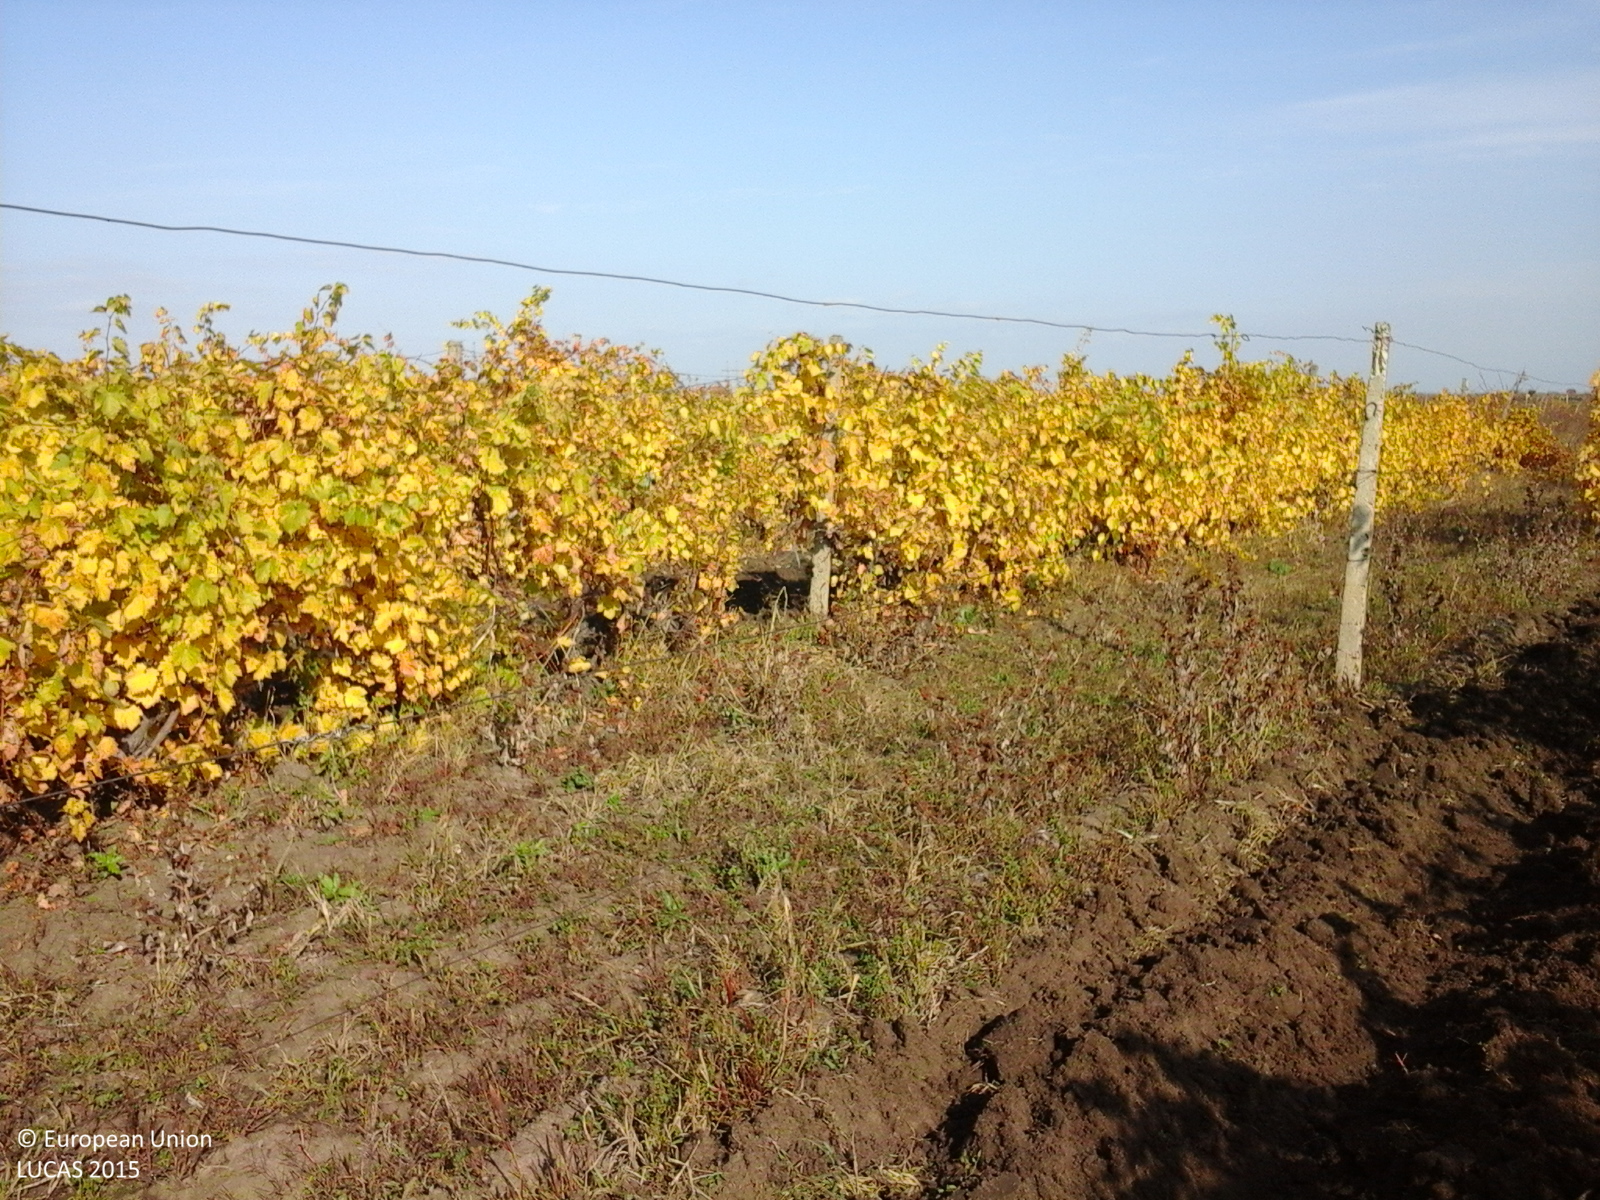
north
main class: Cropland
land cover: Vineyards
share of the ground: > 75 %
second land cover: Other bare soil
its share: > 75 %
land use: Agriculture (excluding fallow land and kitchen gardens)
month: October
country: RO
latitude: 45.5824
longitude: 27.1251
